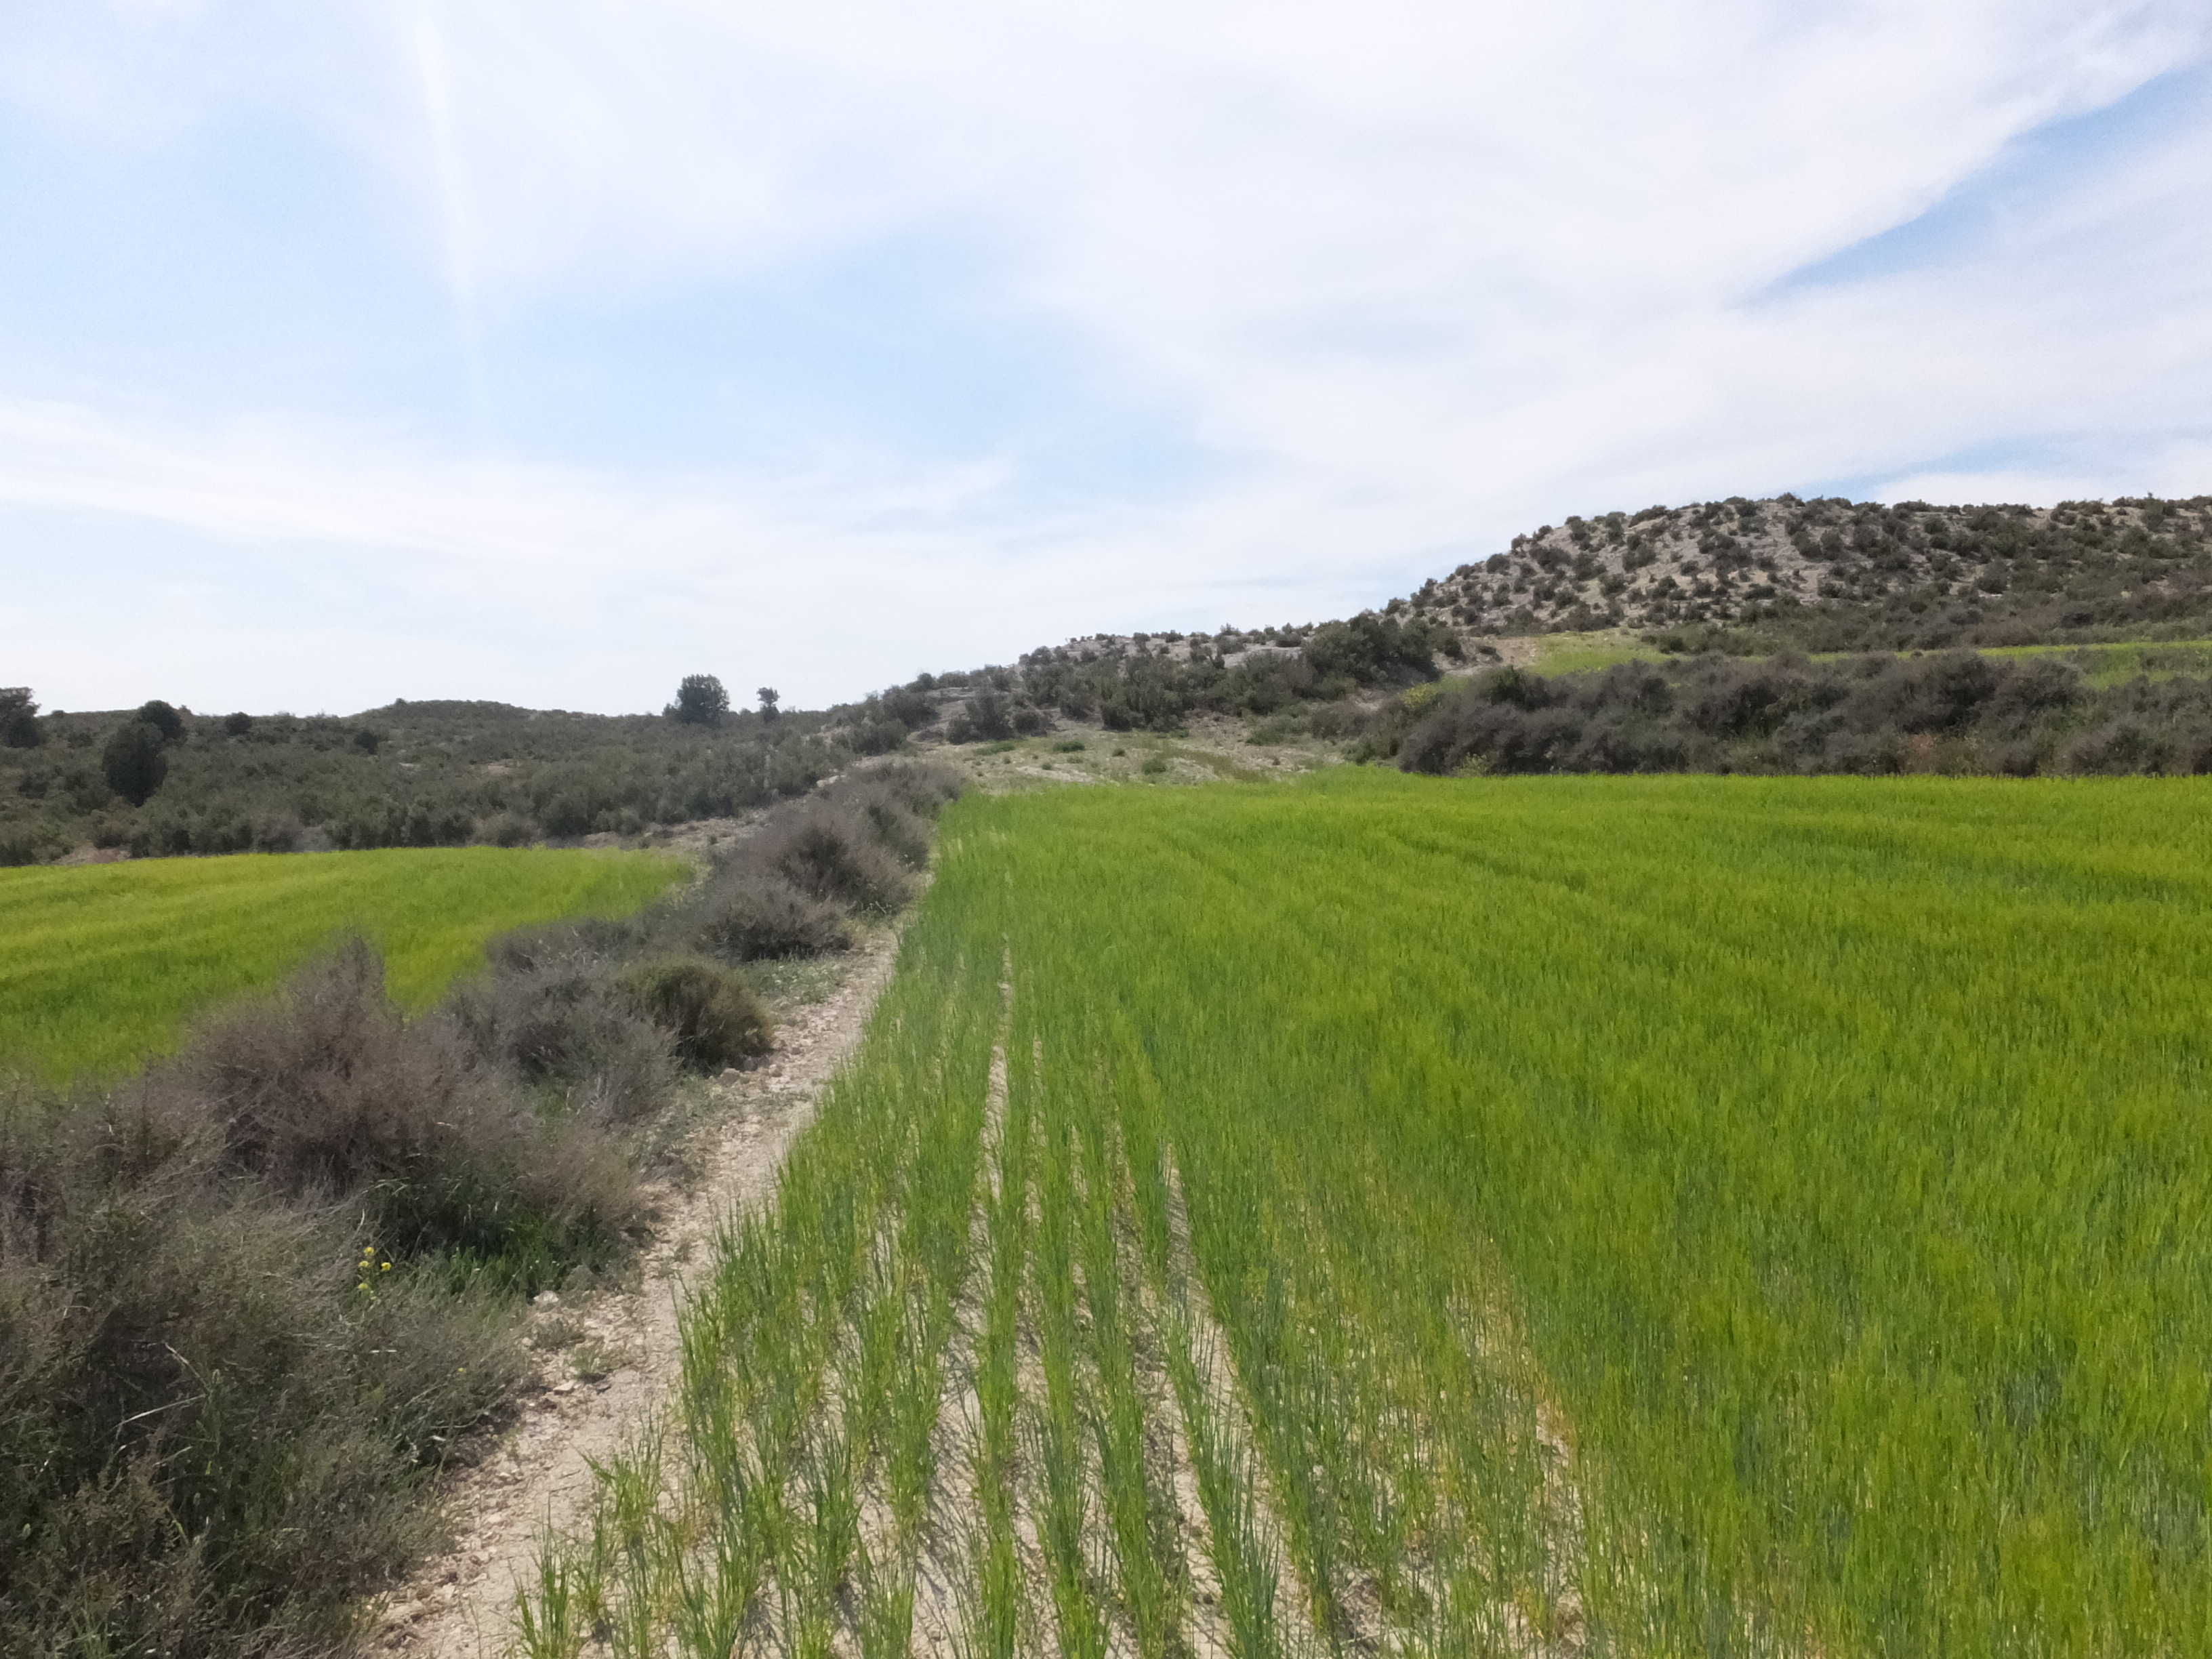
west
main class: Cropland
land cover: Barley
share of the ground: > 75 %
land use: Agriculture (excluding fallow land and kitchen gardens)
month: April
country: ES
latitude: 41.6104
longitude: -0.3737
